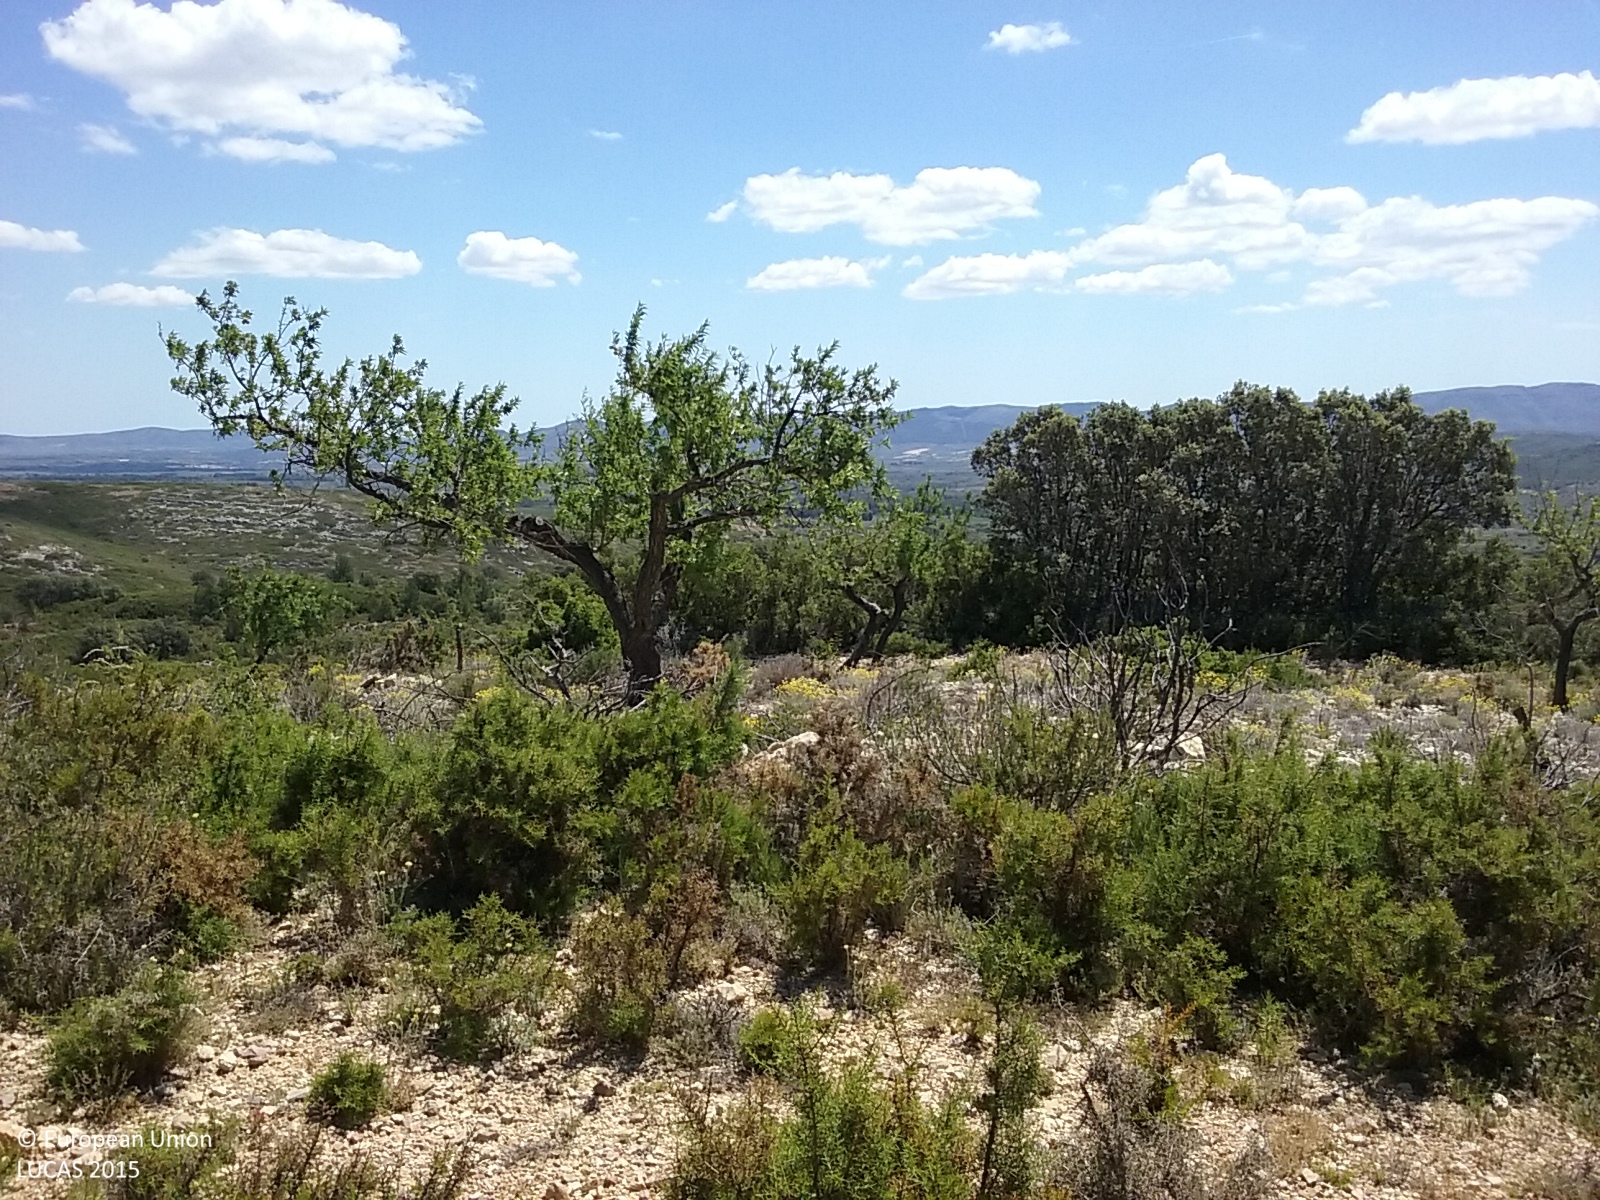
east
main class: Shrubland
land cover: Shrubland with sparse tree cover
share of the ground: > 75 %
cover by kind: shrubs 95 %, broadleaved forest trees 5 %
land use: Semi-natural and natural areas not in use
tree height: < 5 m
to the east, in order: Shrubland with sparse tree cover; Nuts trees; Dry stone walls; Nuts trees; Dry stone walls; Shrubland with sparse tree cover; Tracks; Shrubland with sparse tree cover; Tracks; Shrubland with sparse tree cover; Dry stone walls; Nuts trees; Dry stone walls; Nuts trees; Dry stone walls; Nuts trees; Dry stone walls; Nuts trees; Rocks and stones; Shrubland with sparse tree cover; Dry stone walls; Olive groves
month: May
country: ES
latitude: 40.4553
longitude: 0.0781
